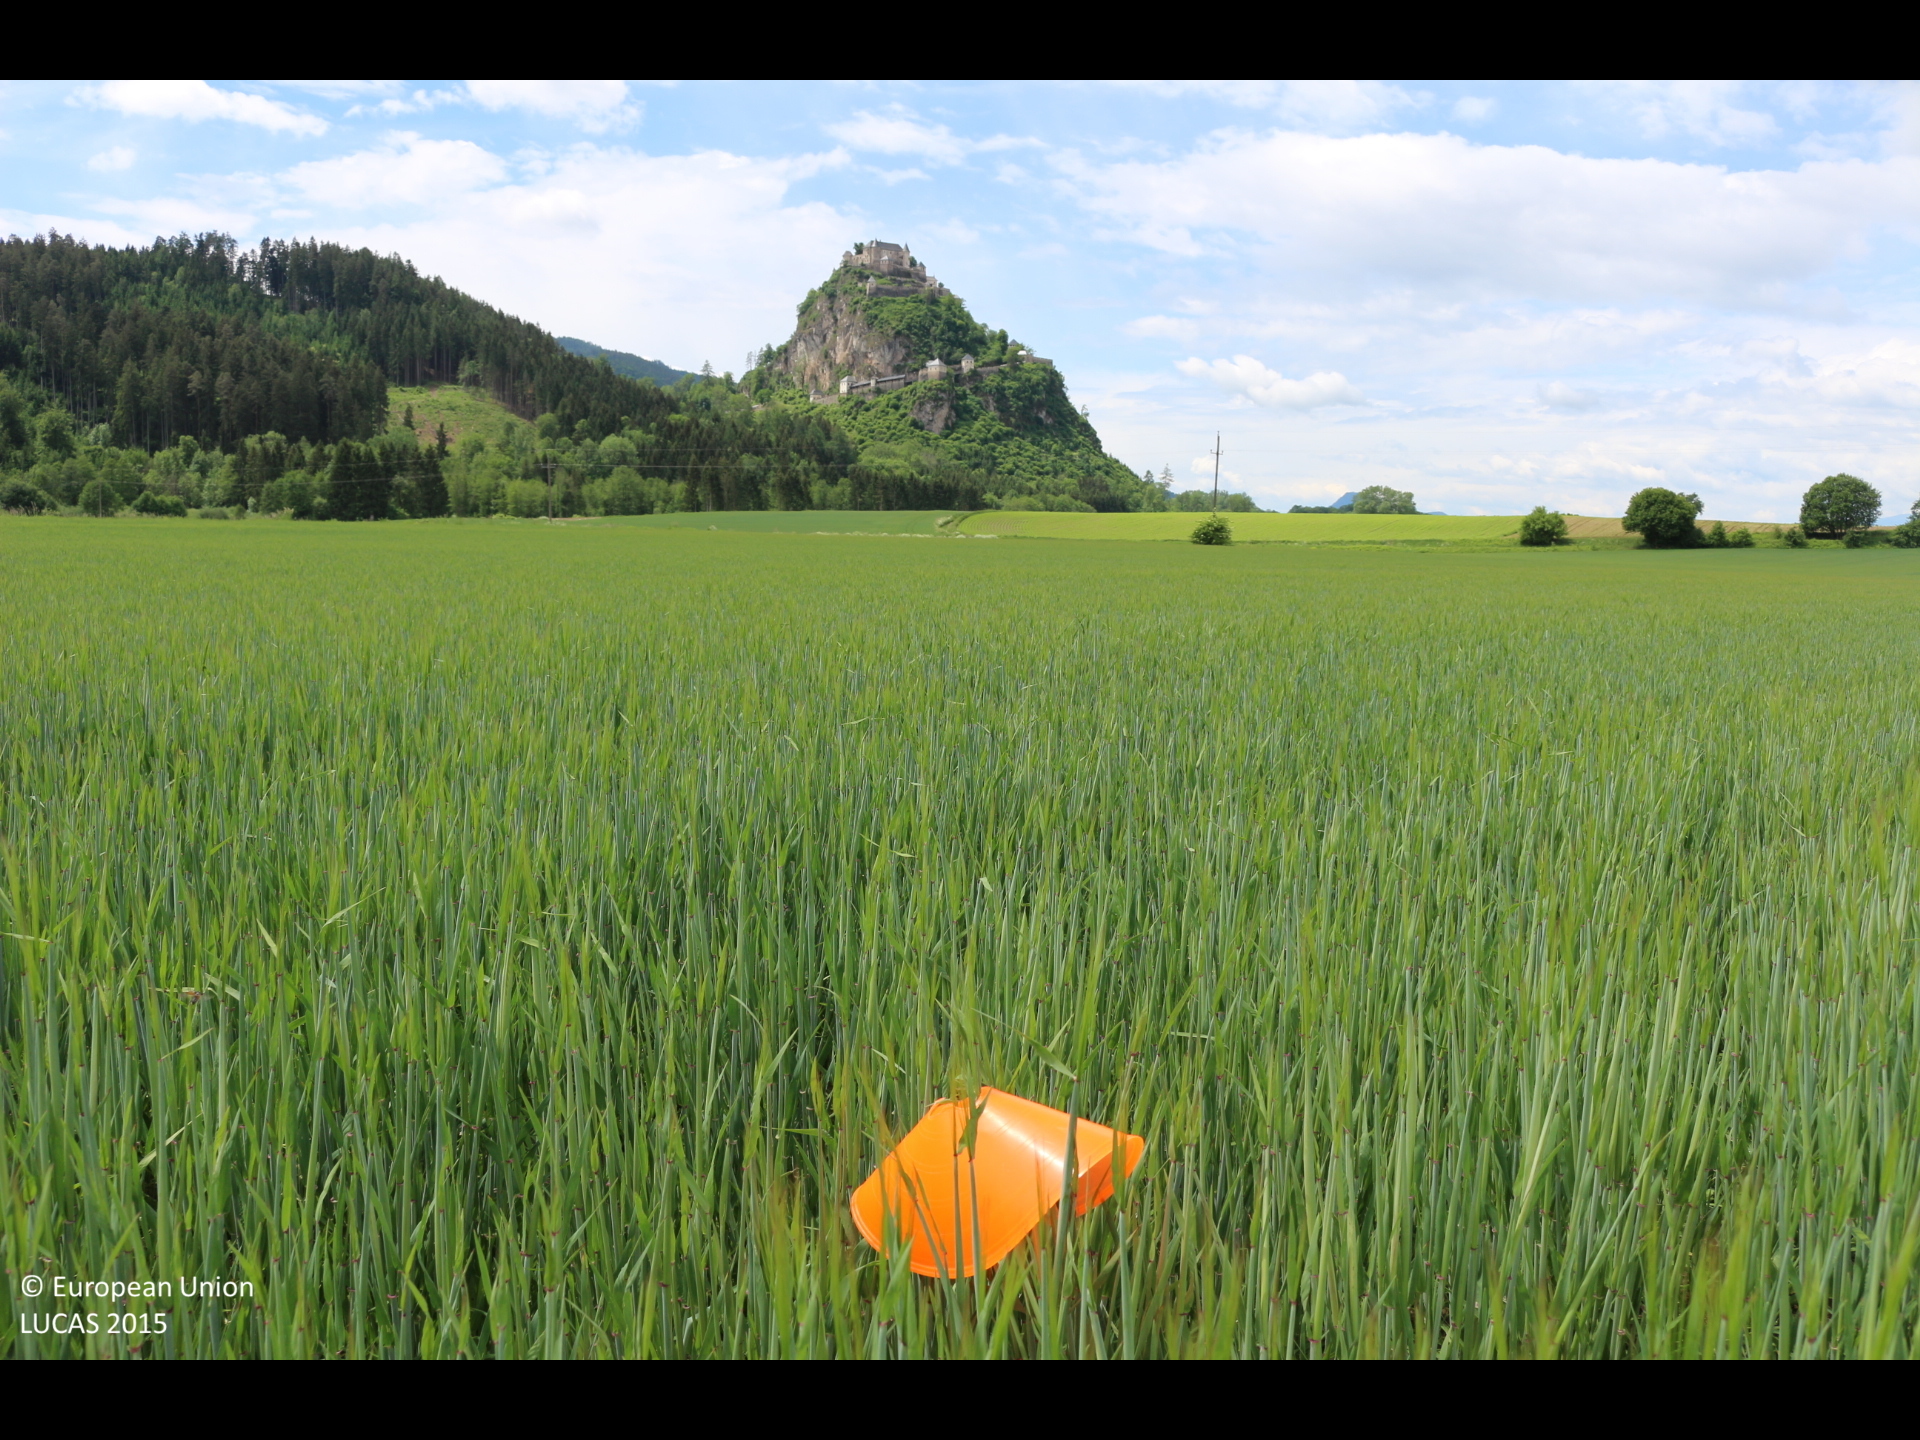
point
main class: Cropland
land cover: Triticale
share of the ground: > 75 %
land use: Agriculture (excluding fallow land and kitchen gardens)
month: May
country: AT
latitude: 46.7631
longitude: 14.4627
